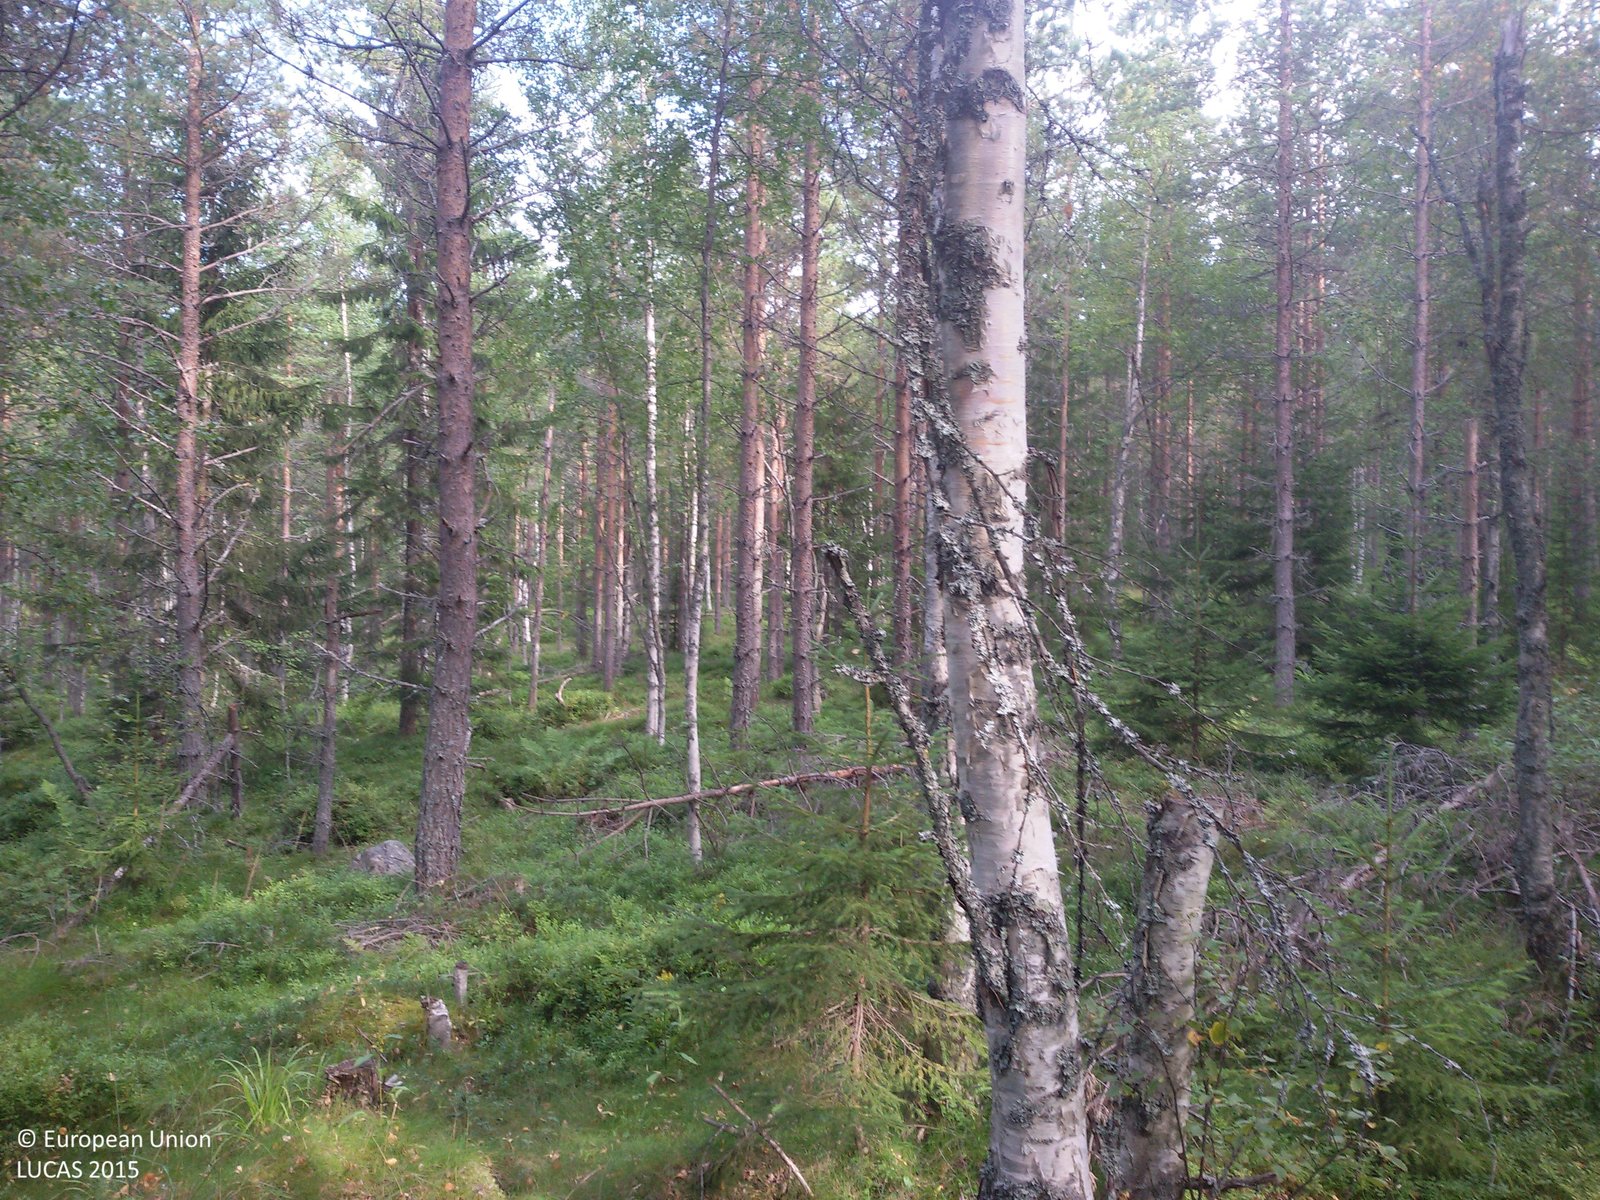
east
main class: Woodland
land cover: Pine dominated mixed woodland
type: boreal forest
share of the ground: > 75 %
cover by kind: coniferous forest trees 50 %, broadleaved forest trees 25 %, herbaceous plants 15 %, lichens and mosses 10 %
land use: Forestry
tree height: > 5 m
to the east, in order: Pine dominated mixed woodland; Pine dominated coniferous woodland
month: August
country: SE
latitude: 60.8640
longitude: 16.0442
